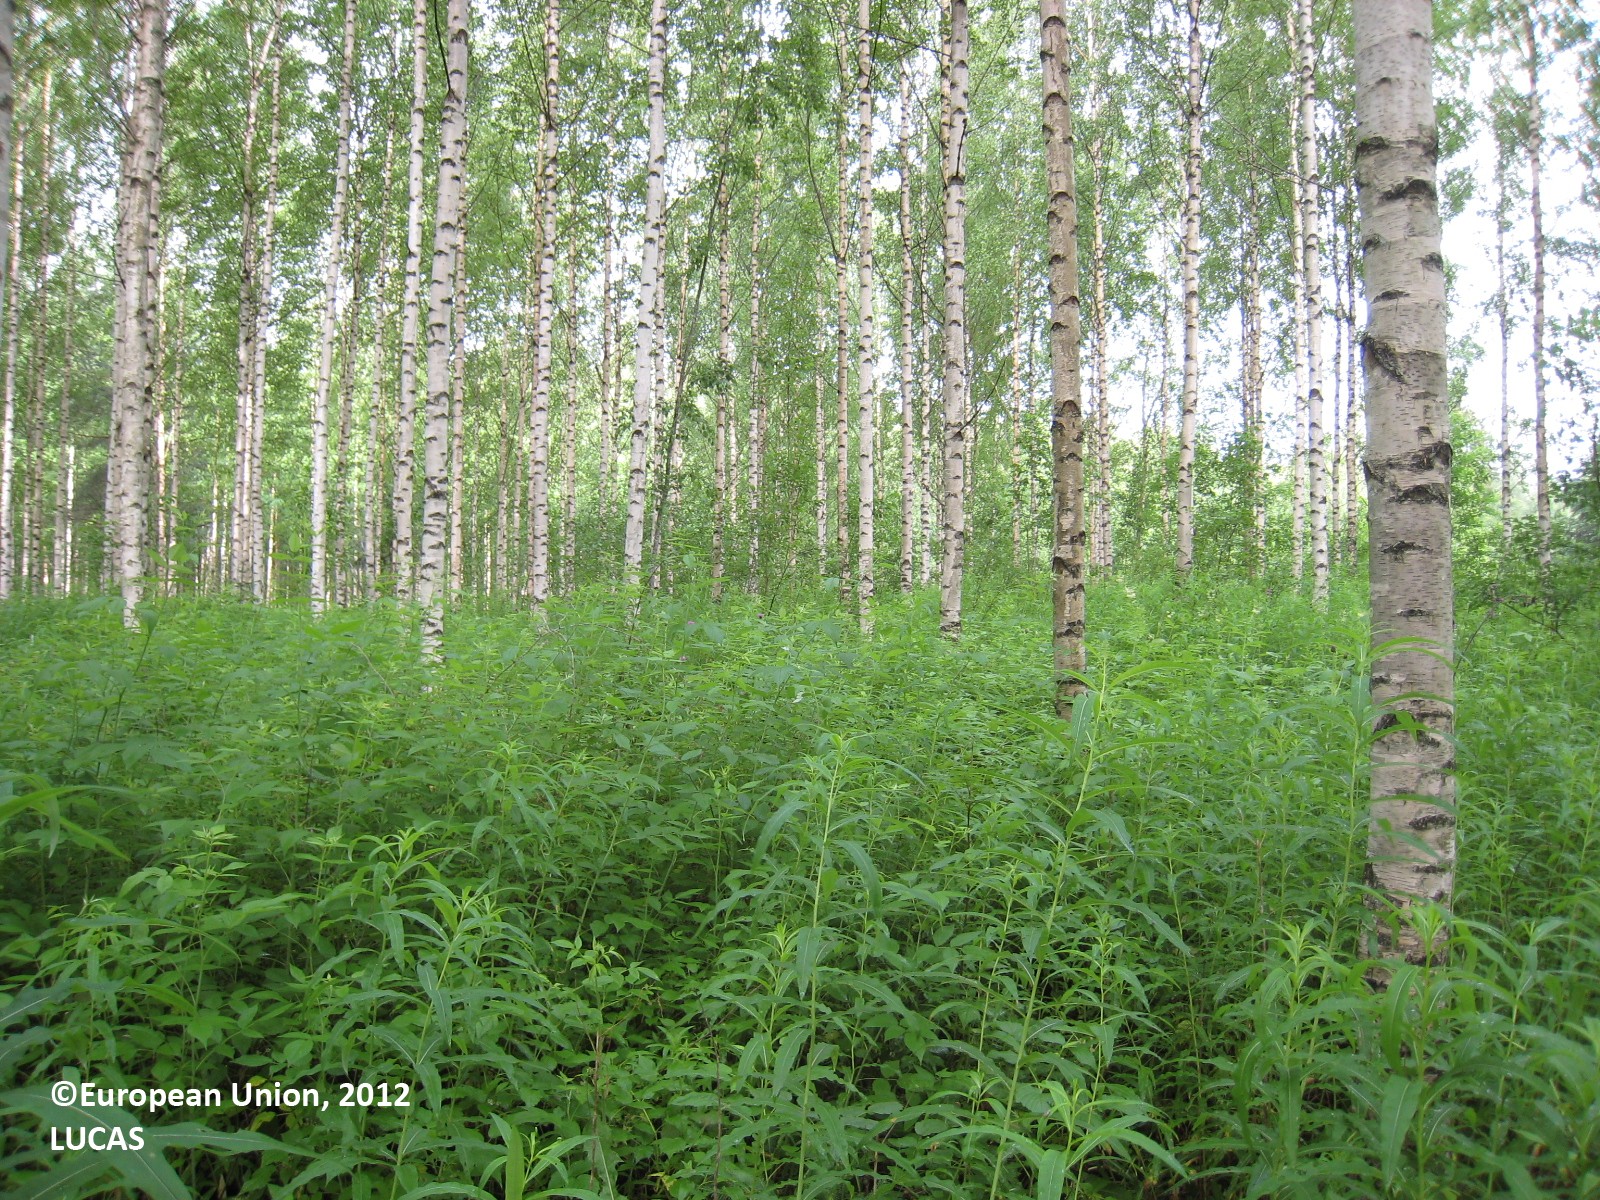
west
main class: Woodland
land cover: Broadleaved woodland
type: non-riverine alder, birch or aspen forest
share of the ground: > 75 %
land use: Forestry
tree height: > 5 m
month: July
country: FI
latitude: 61.8067
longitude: 26.9492
